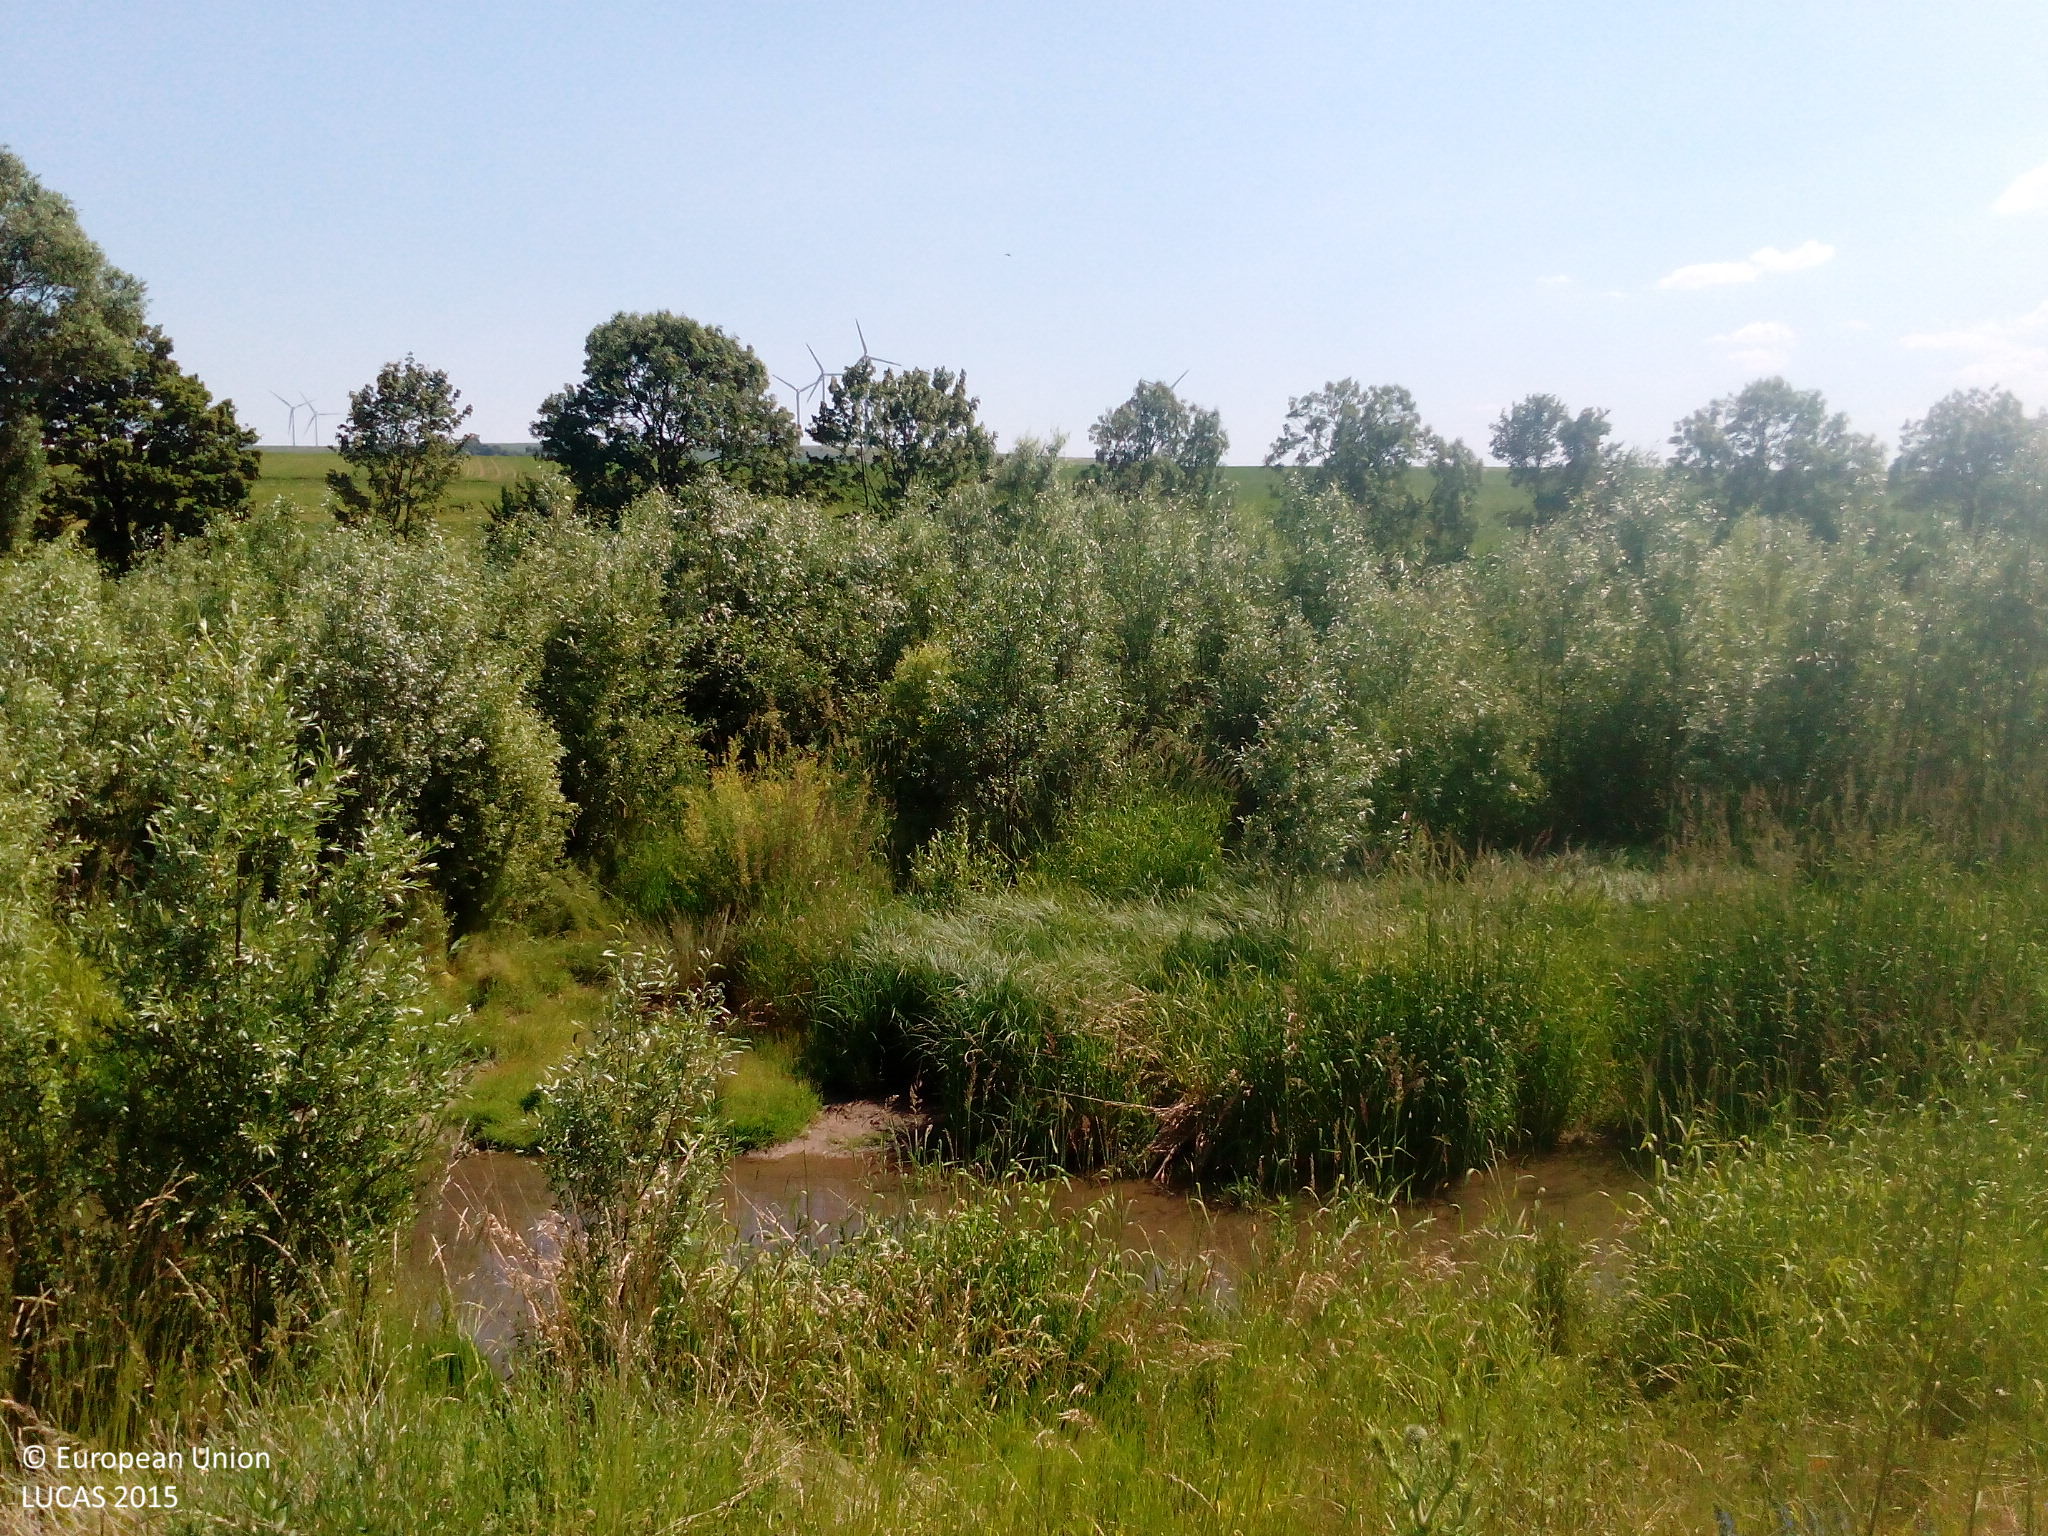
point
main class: Woodland
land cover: Broadleaved woodland
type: floodplain forest
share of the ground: 50 - 75 %
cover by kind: broadleaved forest trees 50 %, herbaceous plants 30 %, shrubs 20 %
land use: Semi-natural and natural areas not in use
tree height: < 5 m
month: June
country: DE
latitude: 49.7556
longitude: 8.1543
